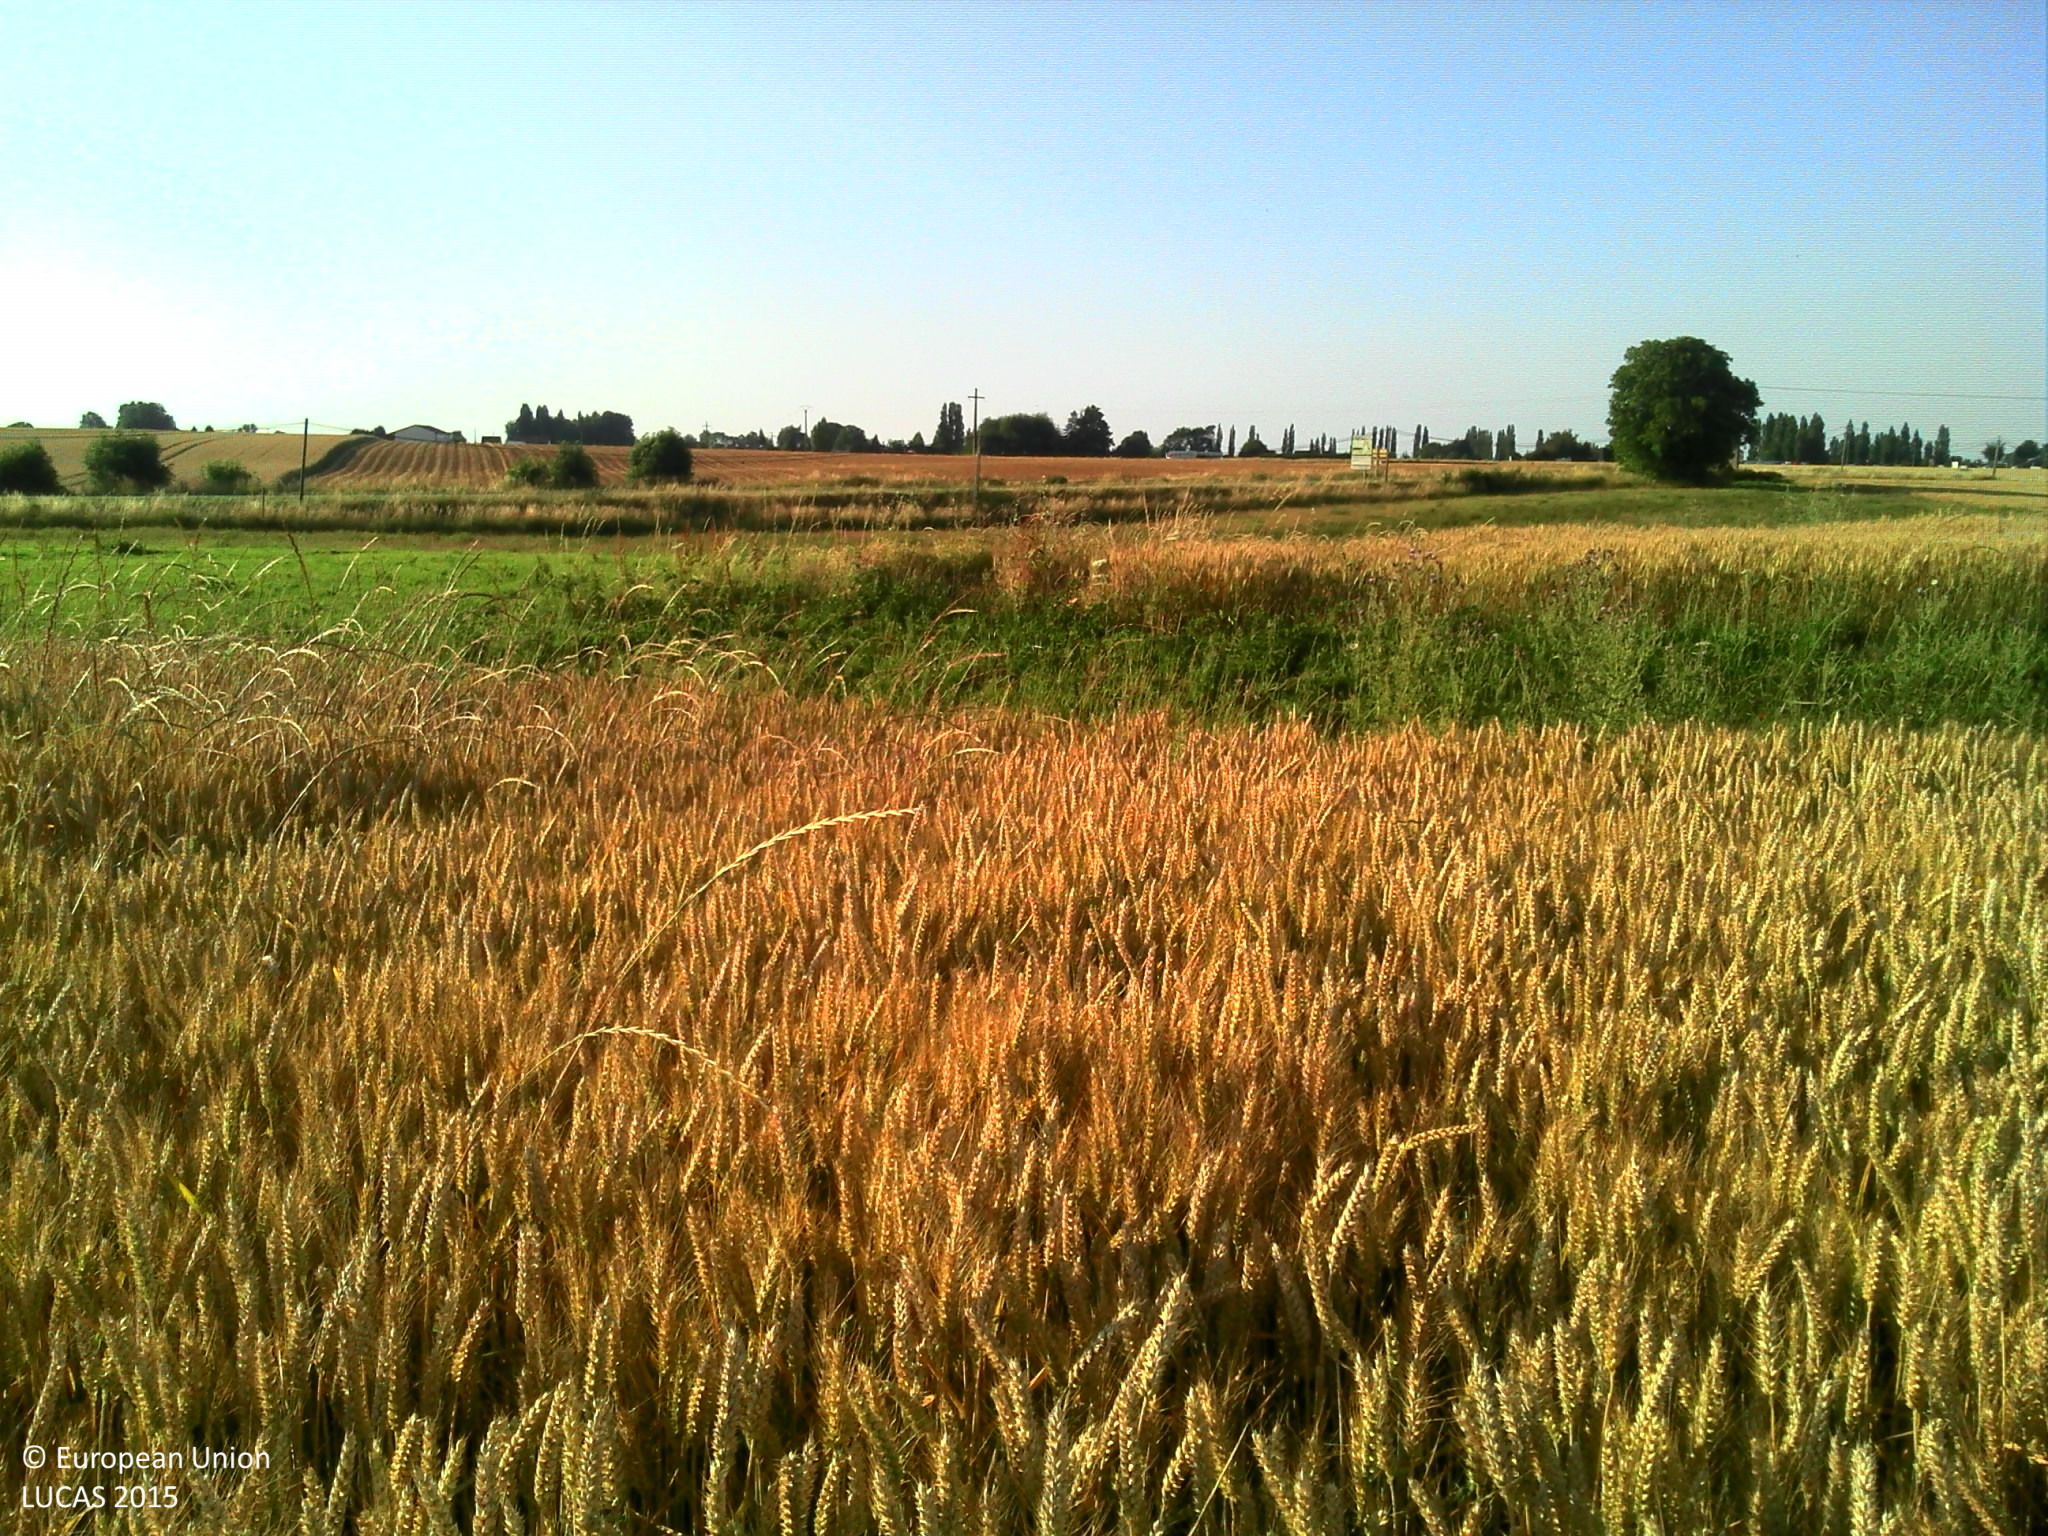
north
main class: Cropland
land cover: Common wheat
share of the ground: > 75 %
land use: Agriculture (excluding fallow land and kitchen gardens)
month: July
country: FR
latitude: 49.1488
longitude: 0.6663
